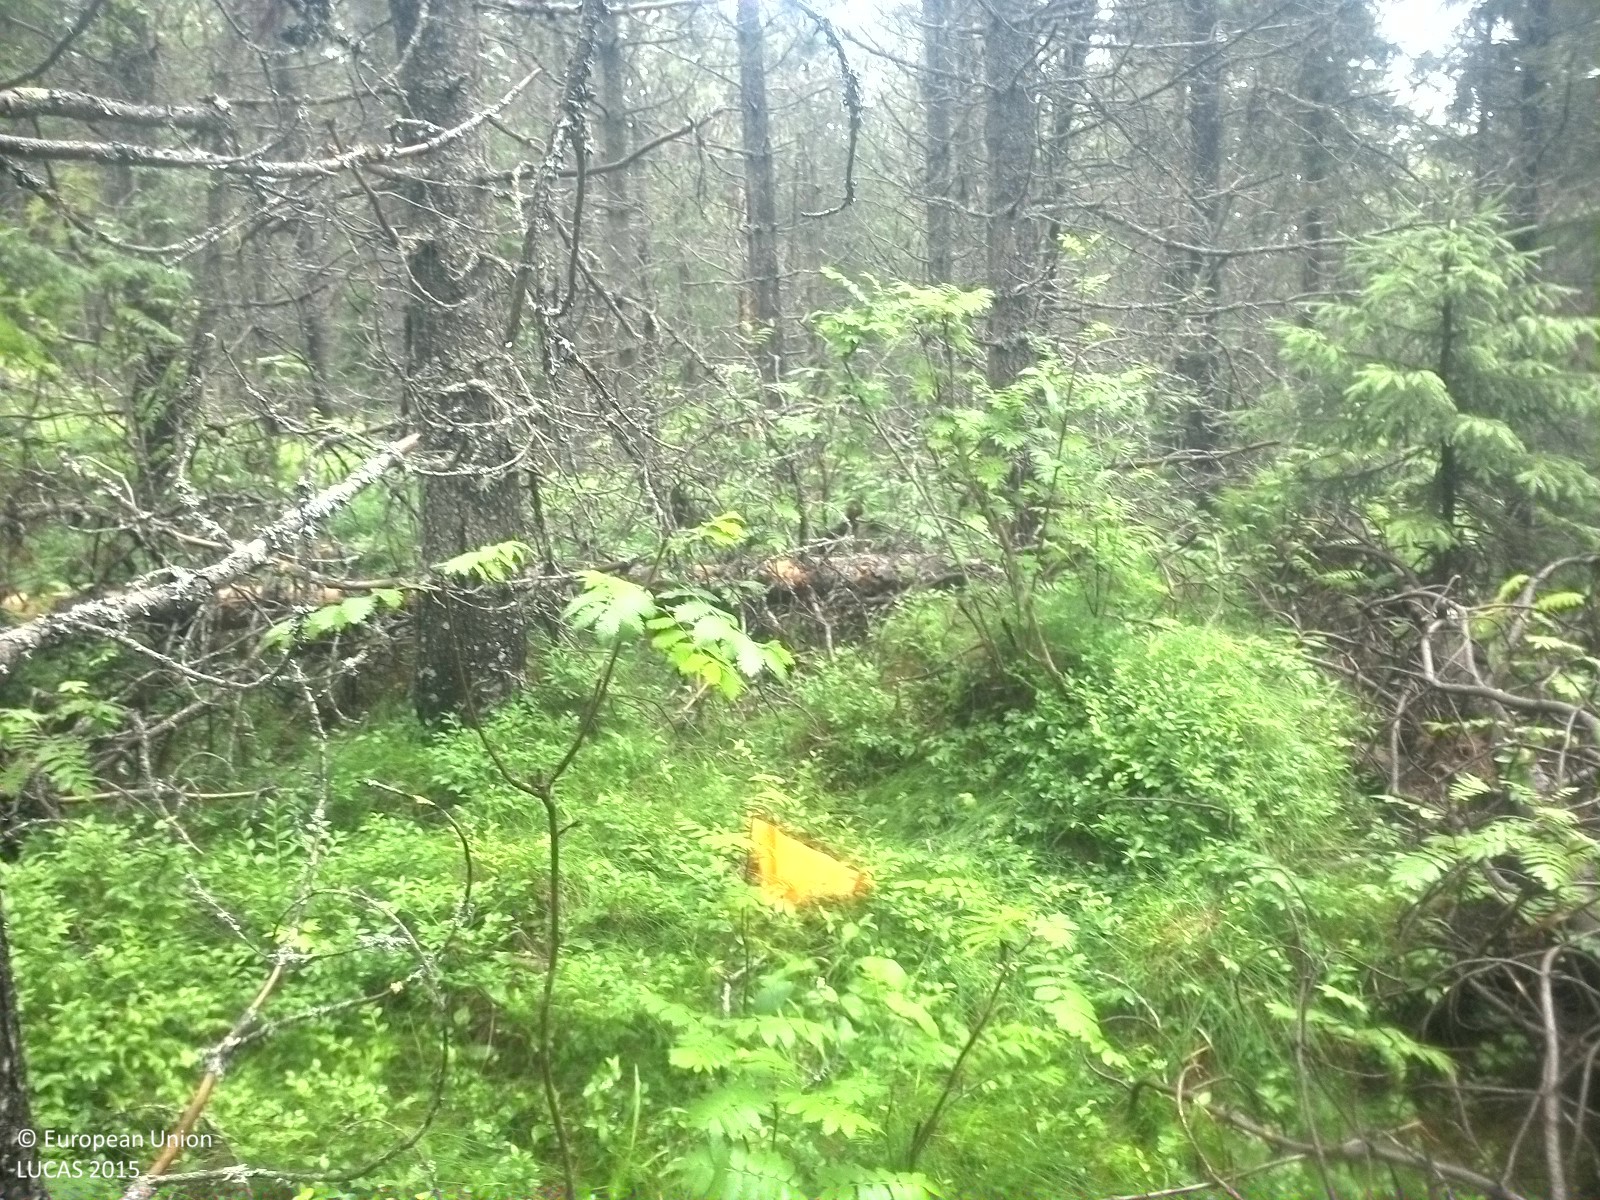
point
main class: Woodland
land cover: Pine dominated coniferous woodland
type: exotic forest
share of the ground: 25 - 50 %
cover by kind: coniferous forest trees 45 %, shrubs 45 %, broadleaved forest trees 5 %, herbaceous plants 5 %
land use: Forestry
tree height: > 5 m
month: July
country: SE
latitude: 62.5115
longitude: 16.8345
